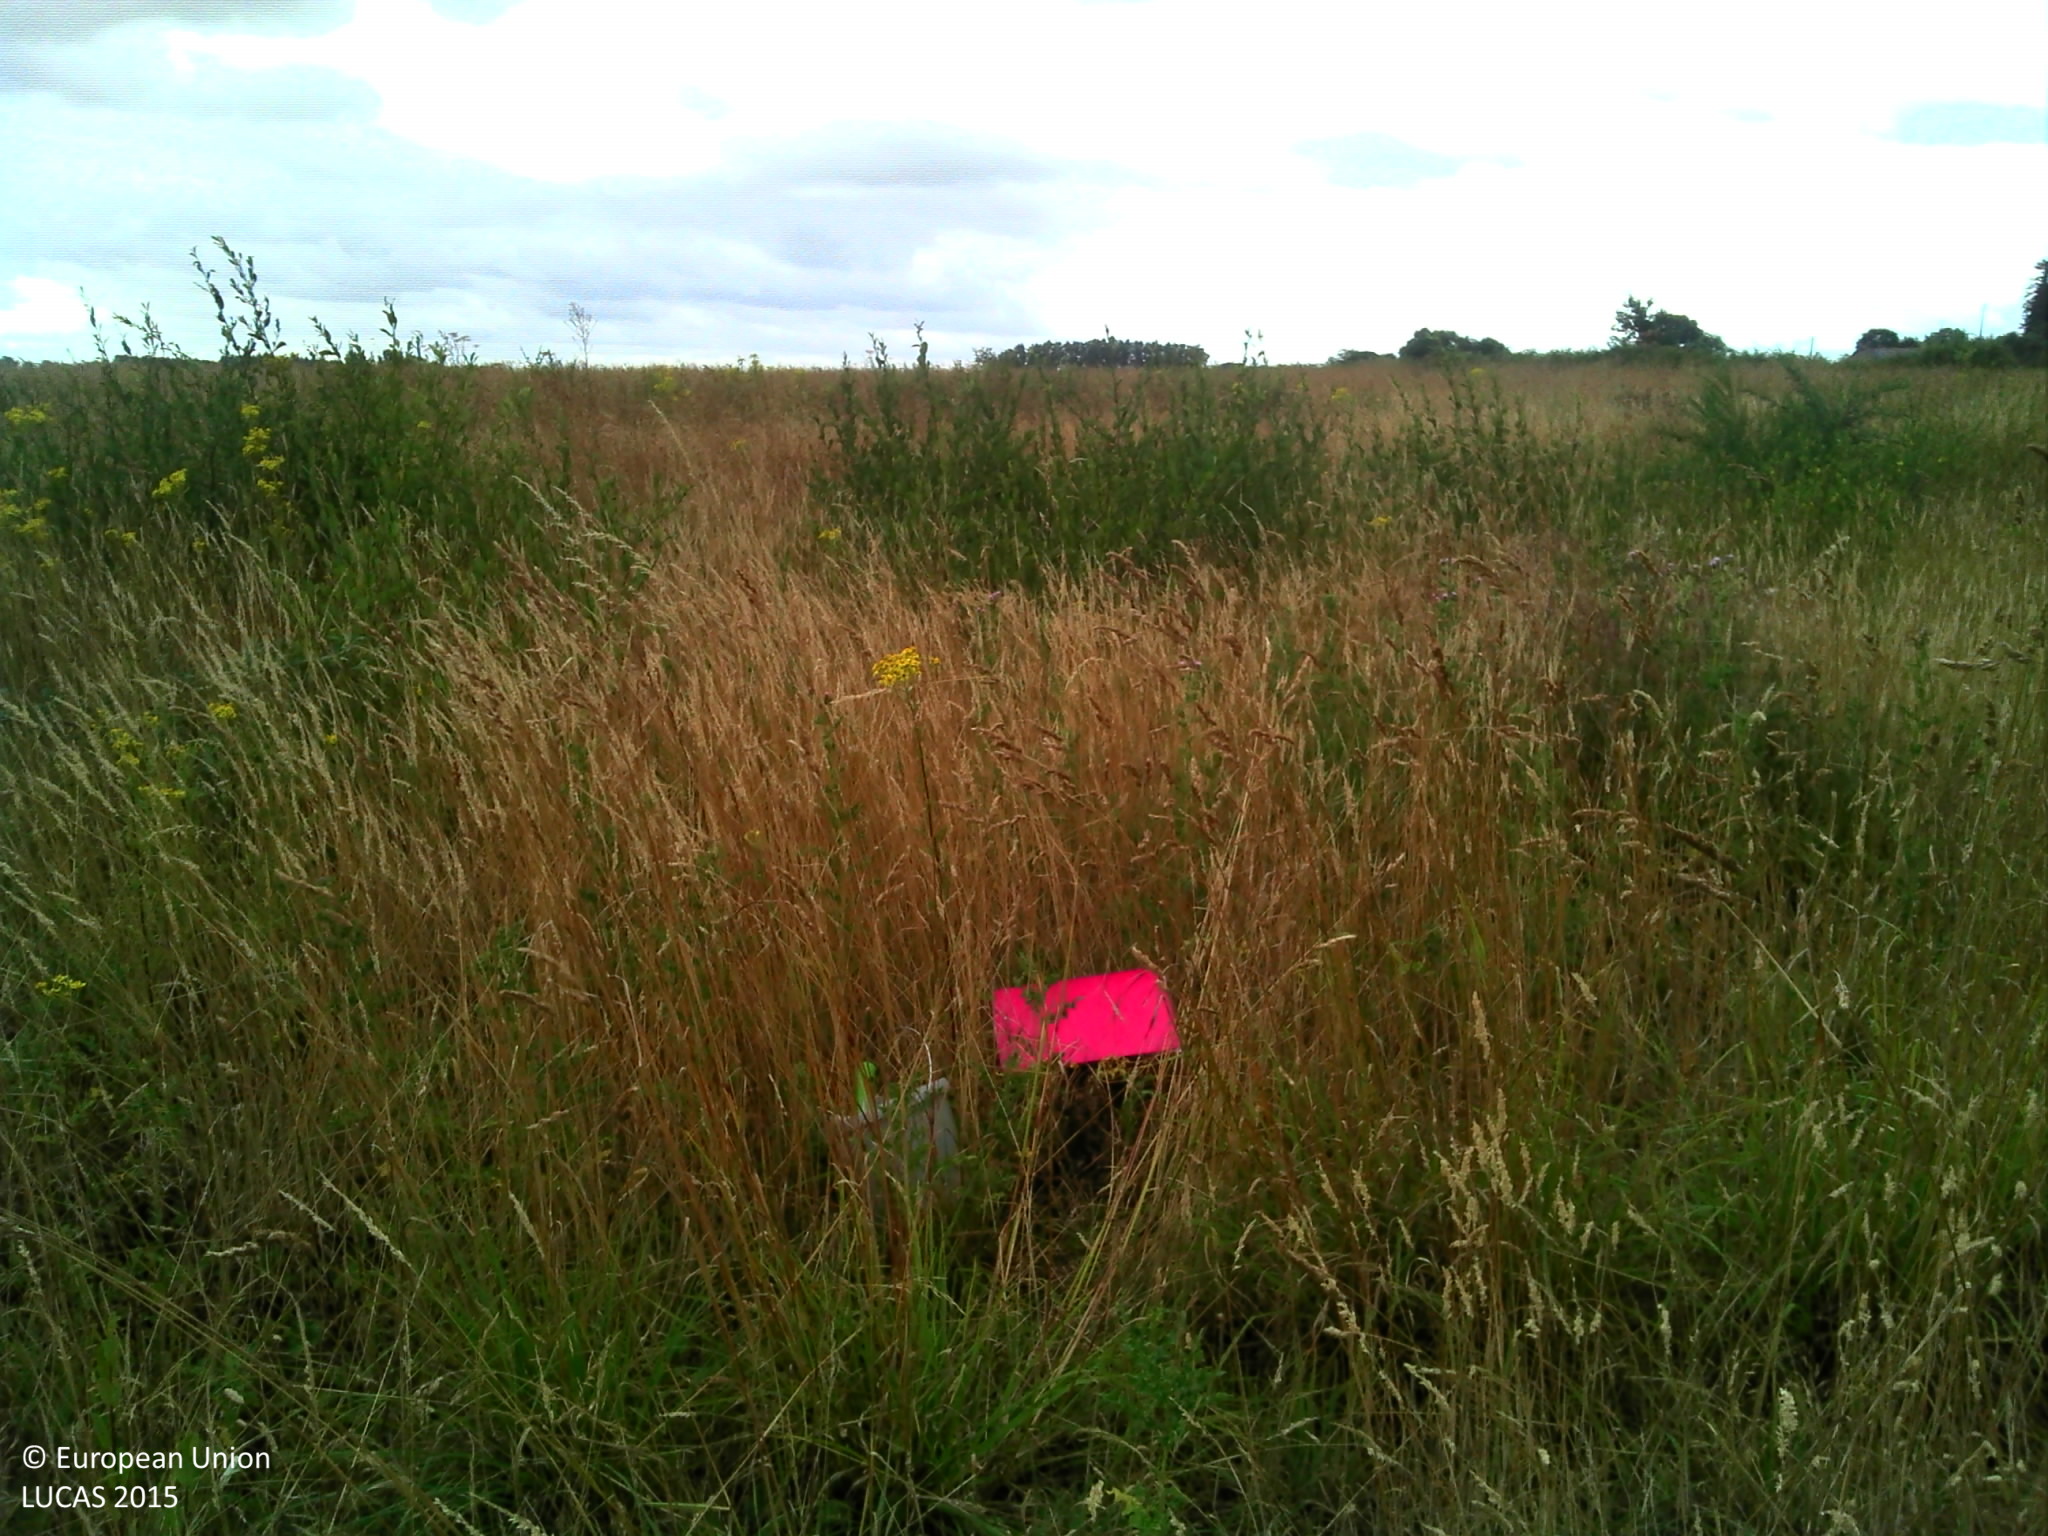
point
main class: Grassland
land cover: Grassland without tree/shrub cover
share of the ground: > 75 %
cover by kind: herbaceous plants 100 %
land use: Agriculture (excluding fallow land and kitchen gardens)
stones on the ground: 10 - 25 %
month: July
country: FR
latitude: 47.8726
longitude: -2.0177
